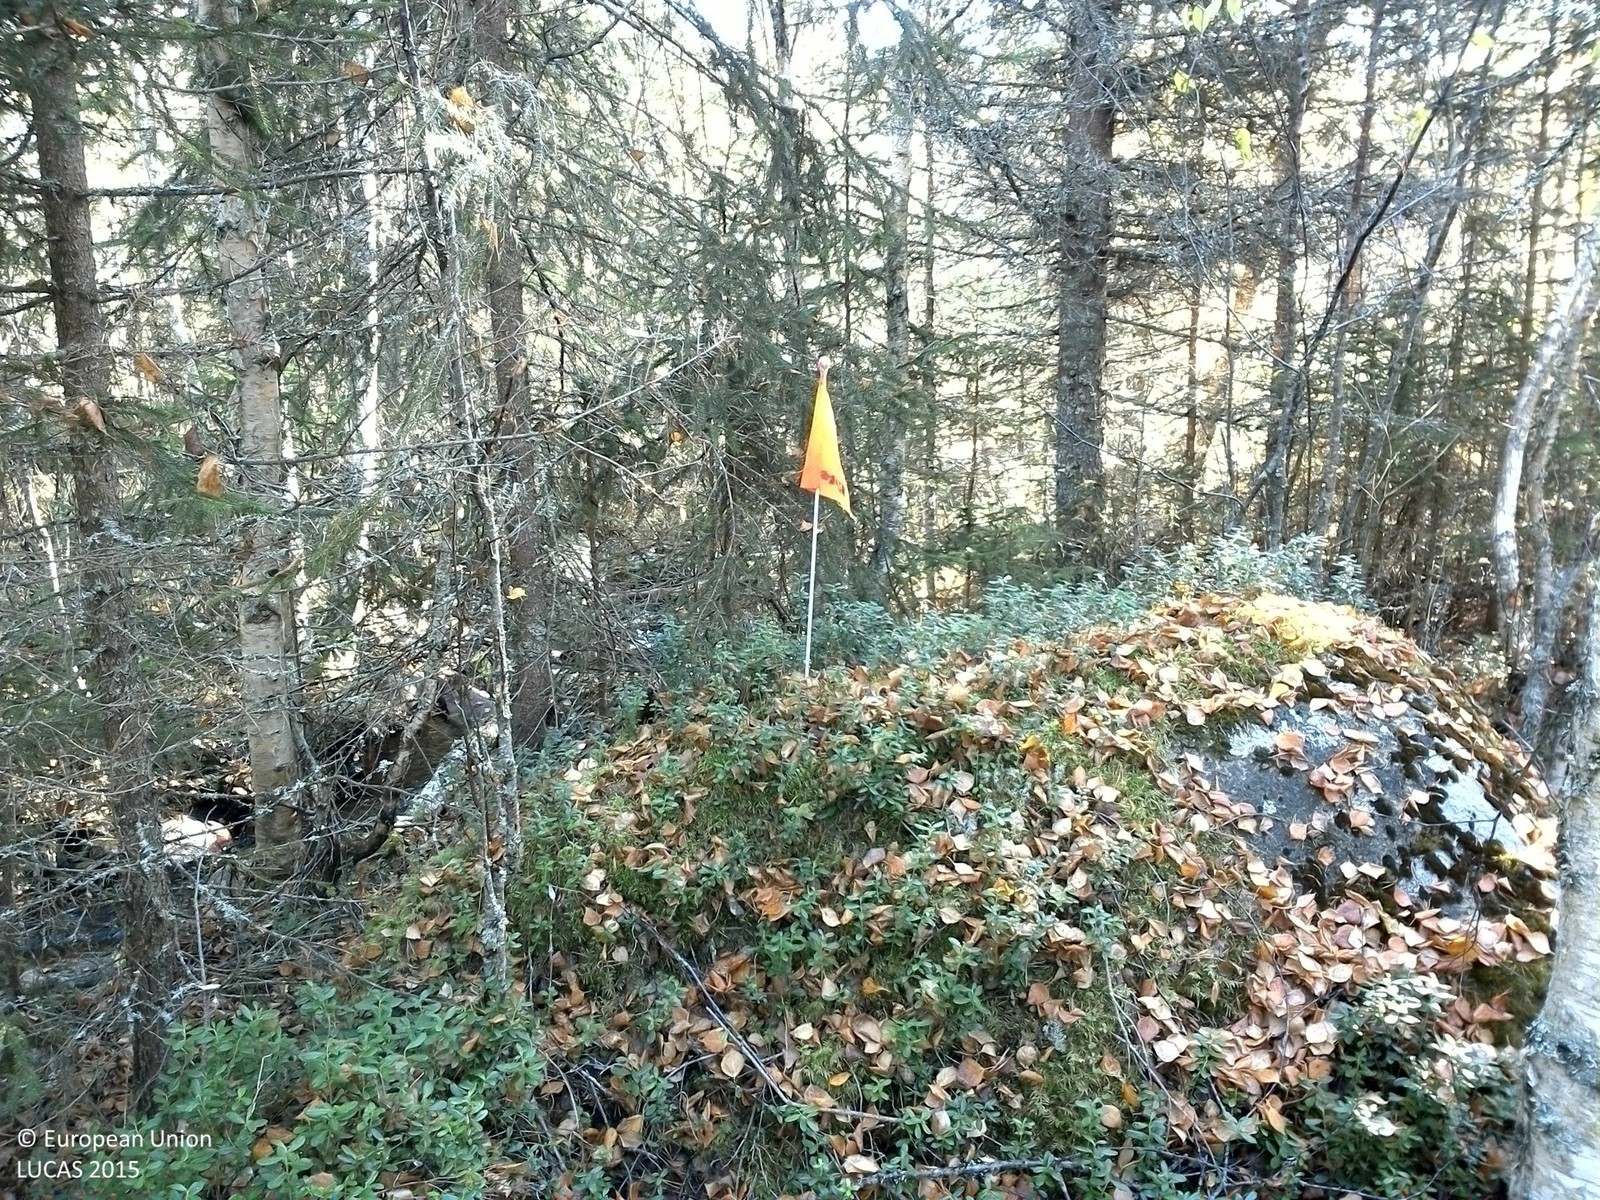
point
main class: Woodland
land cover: Spruce dominated mixed woodland
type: boreal forest
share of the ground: > 75 %
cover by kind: broadleaved forest trees 40 %, coniferous forest trees 35 %, shrubs 15 %, lichens and mosses 10 %
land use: Forestry
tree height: > 5 m
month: October
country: SE
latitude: 61.2112
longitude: 14.9927
